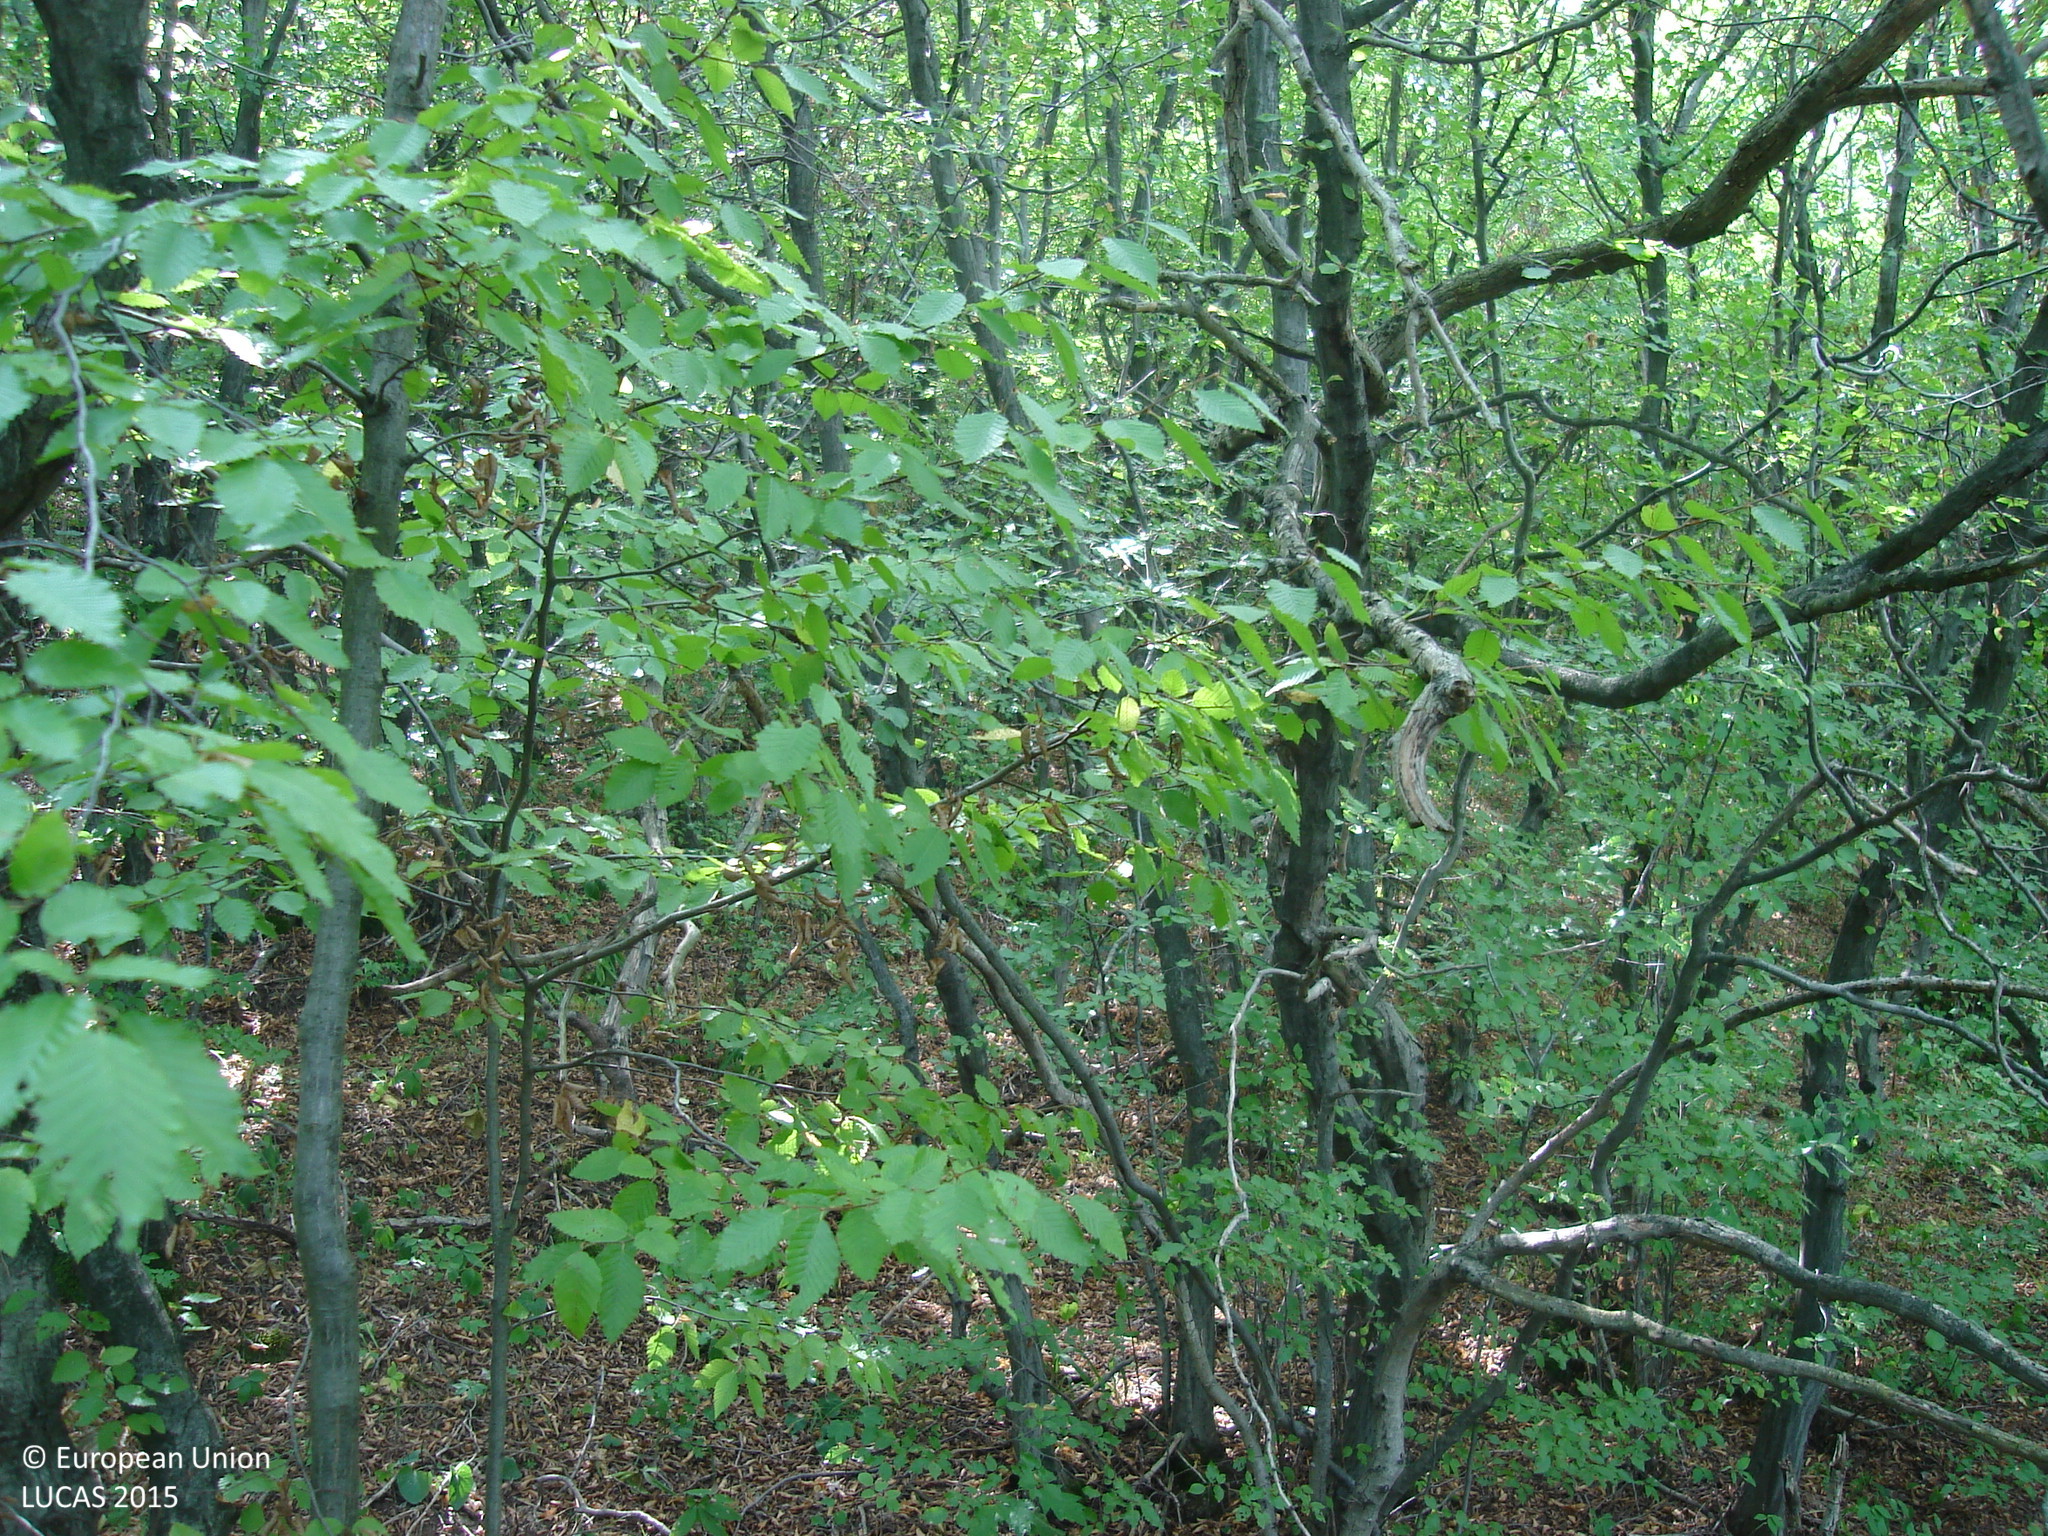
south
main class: Woodland
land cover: Broadleaved woodland
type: beech forest
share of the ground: > 75 %
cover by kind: broadleaved forest trees 85 %, consolidated bare surface 15 %
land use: Forestry
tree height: > 5 m
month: September
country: BG
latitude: 42.6371
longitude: 23.9333
